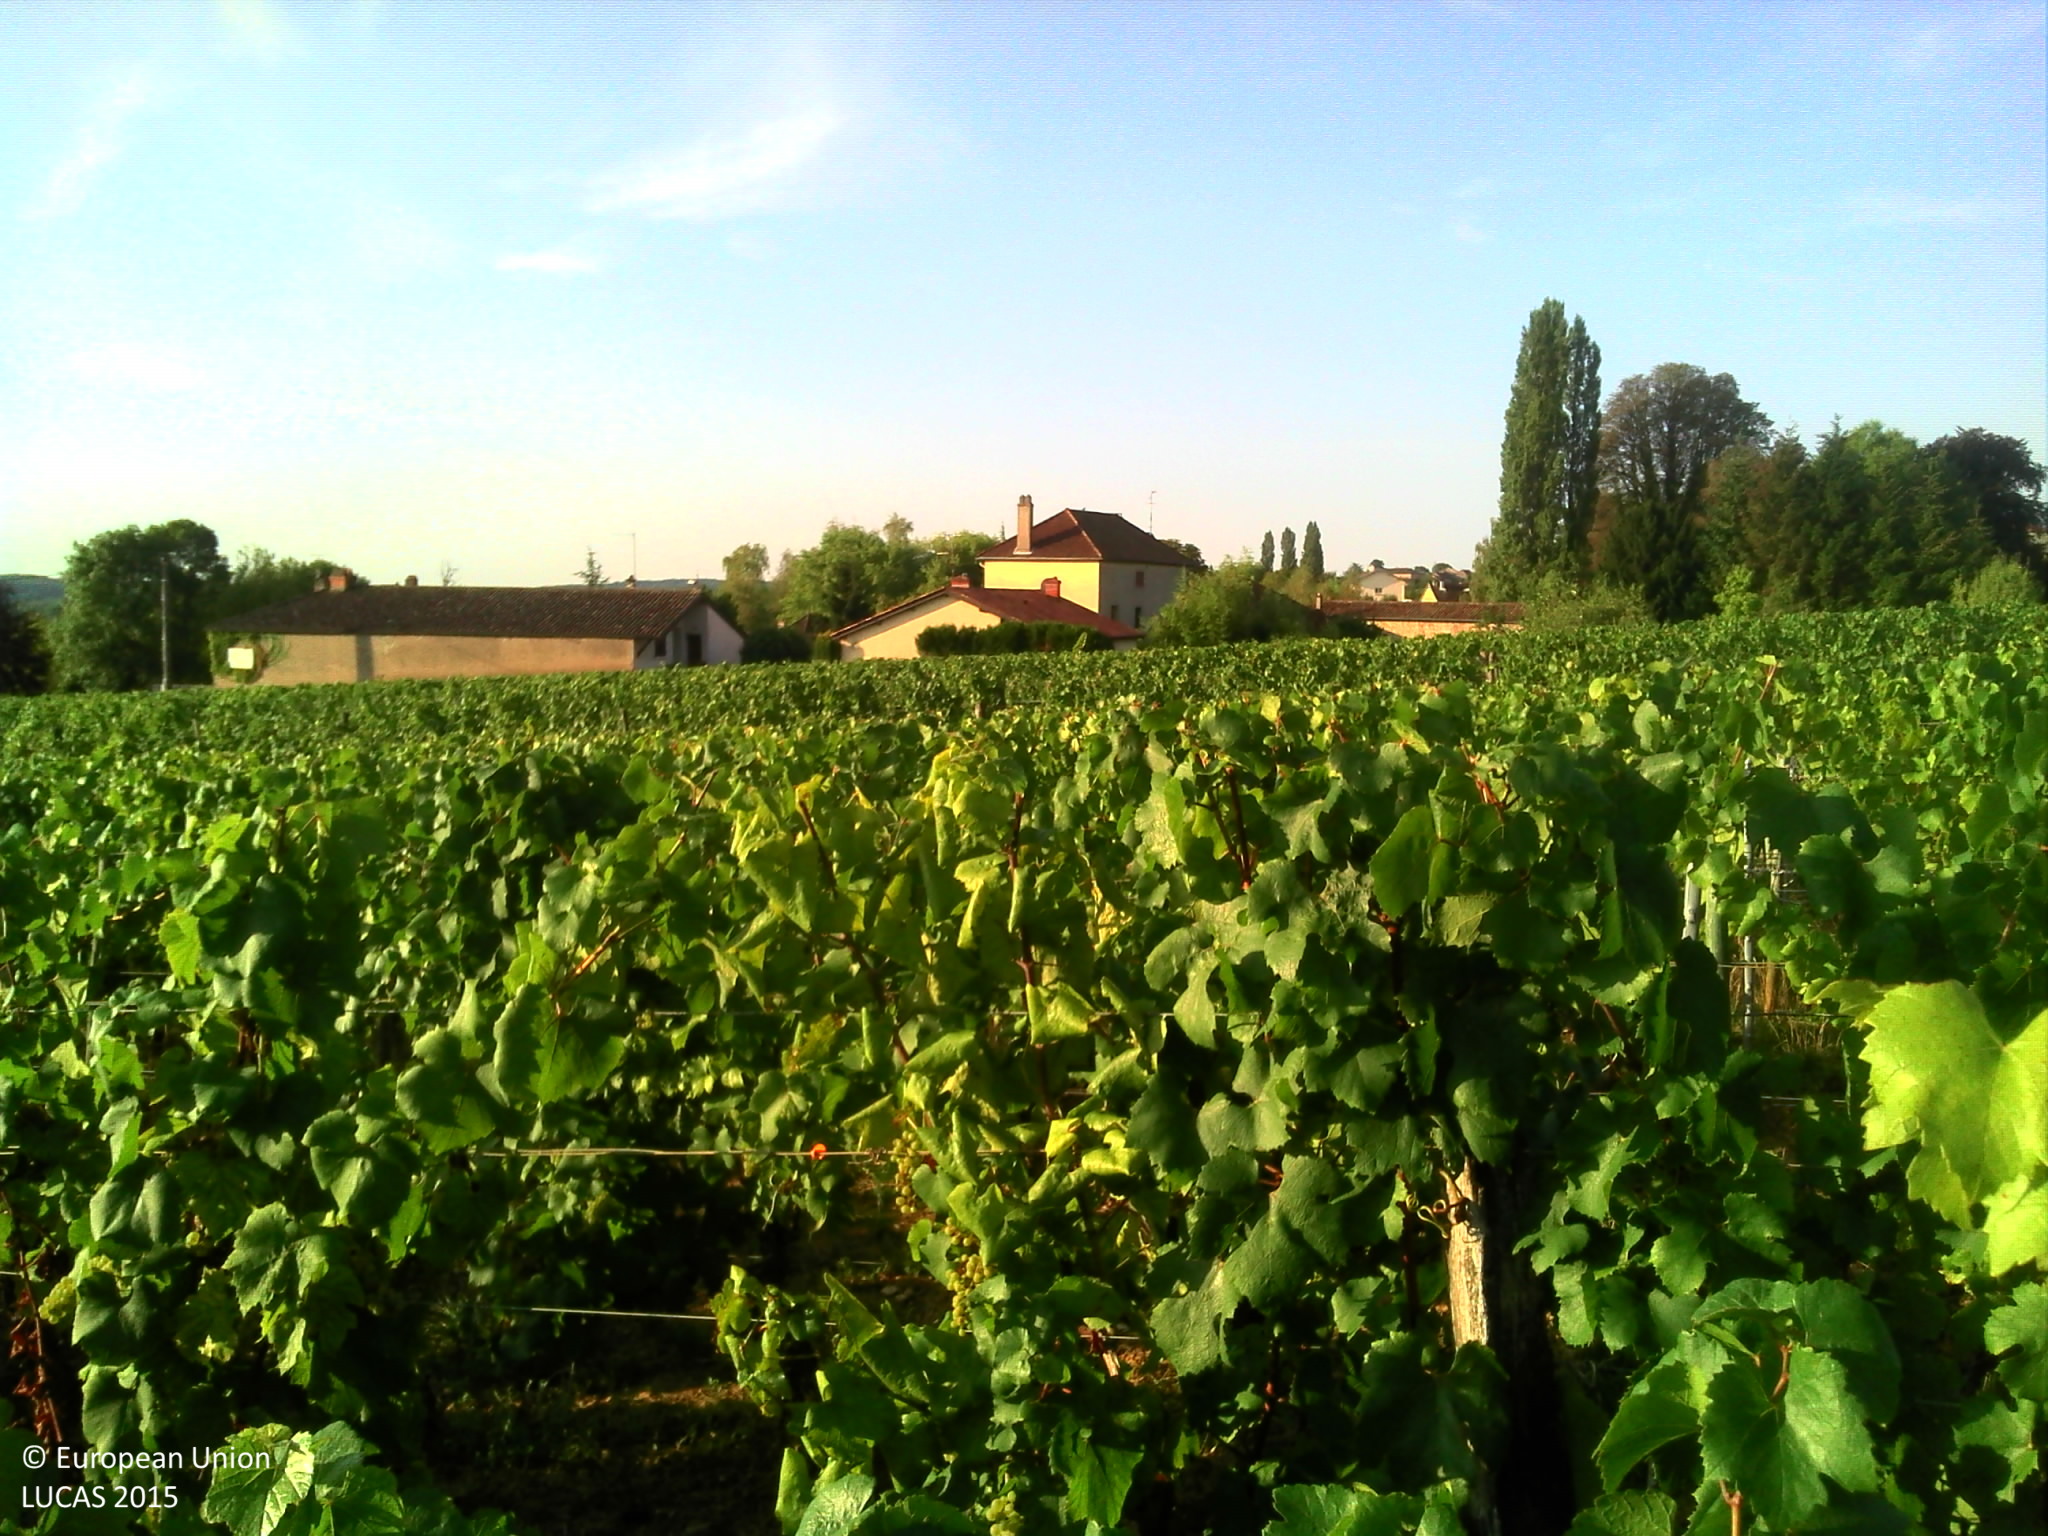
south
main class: Cropland
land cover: Vineyards
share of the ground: 50 - 75 %
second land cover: Other bare soil
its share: > 75 %
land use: Agriculture (excluding fallow land and kitchen gardens)
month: August
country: FR
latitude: 46.4430
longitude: 4.8344
